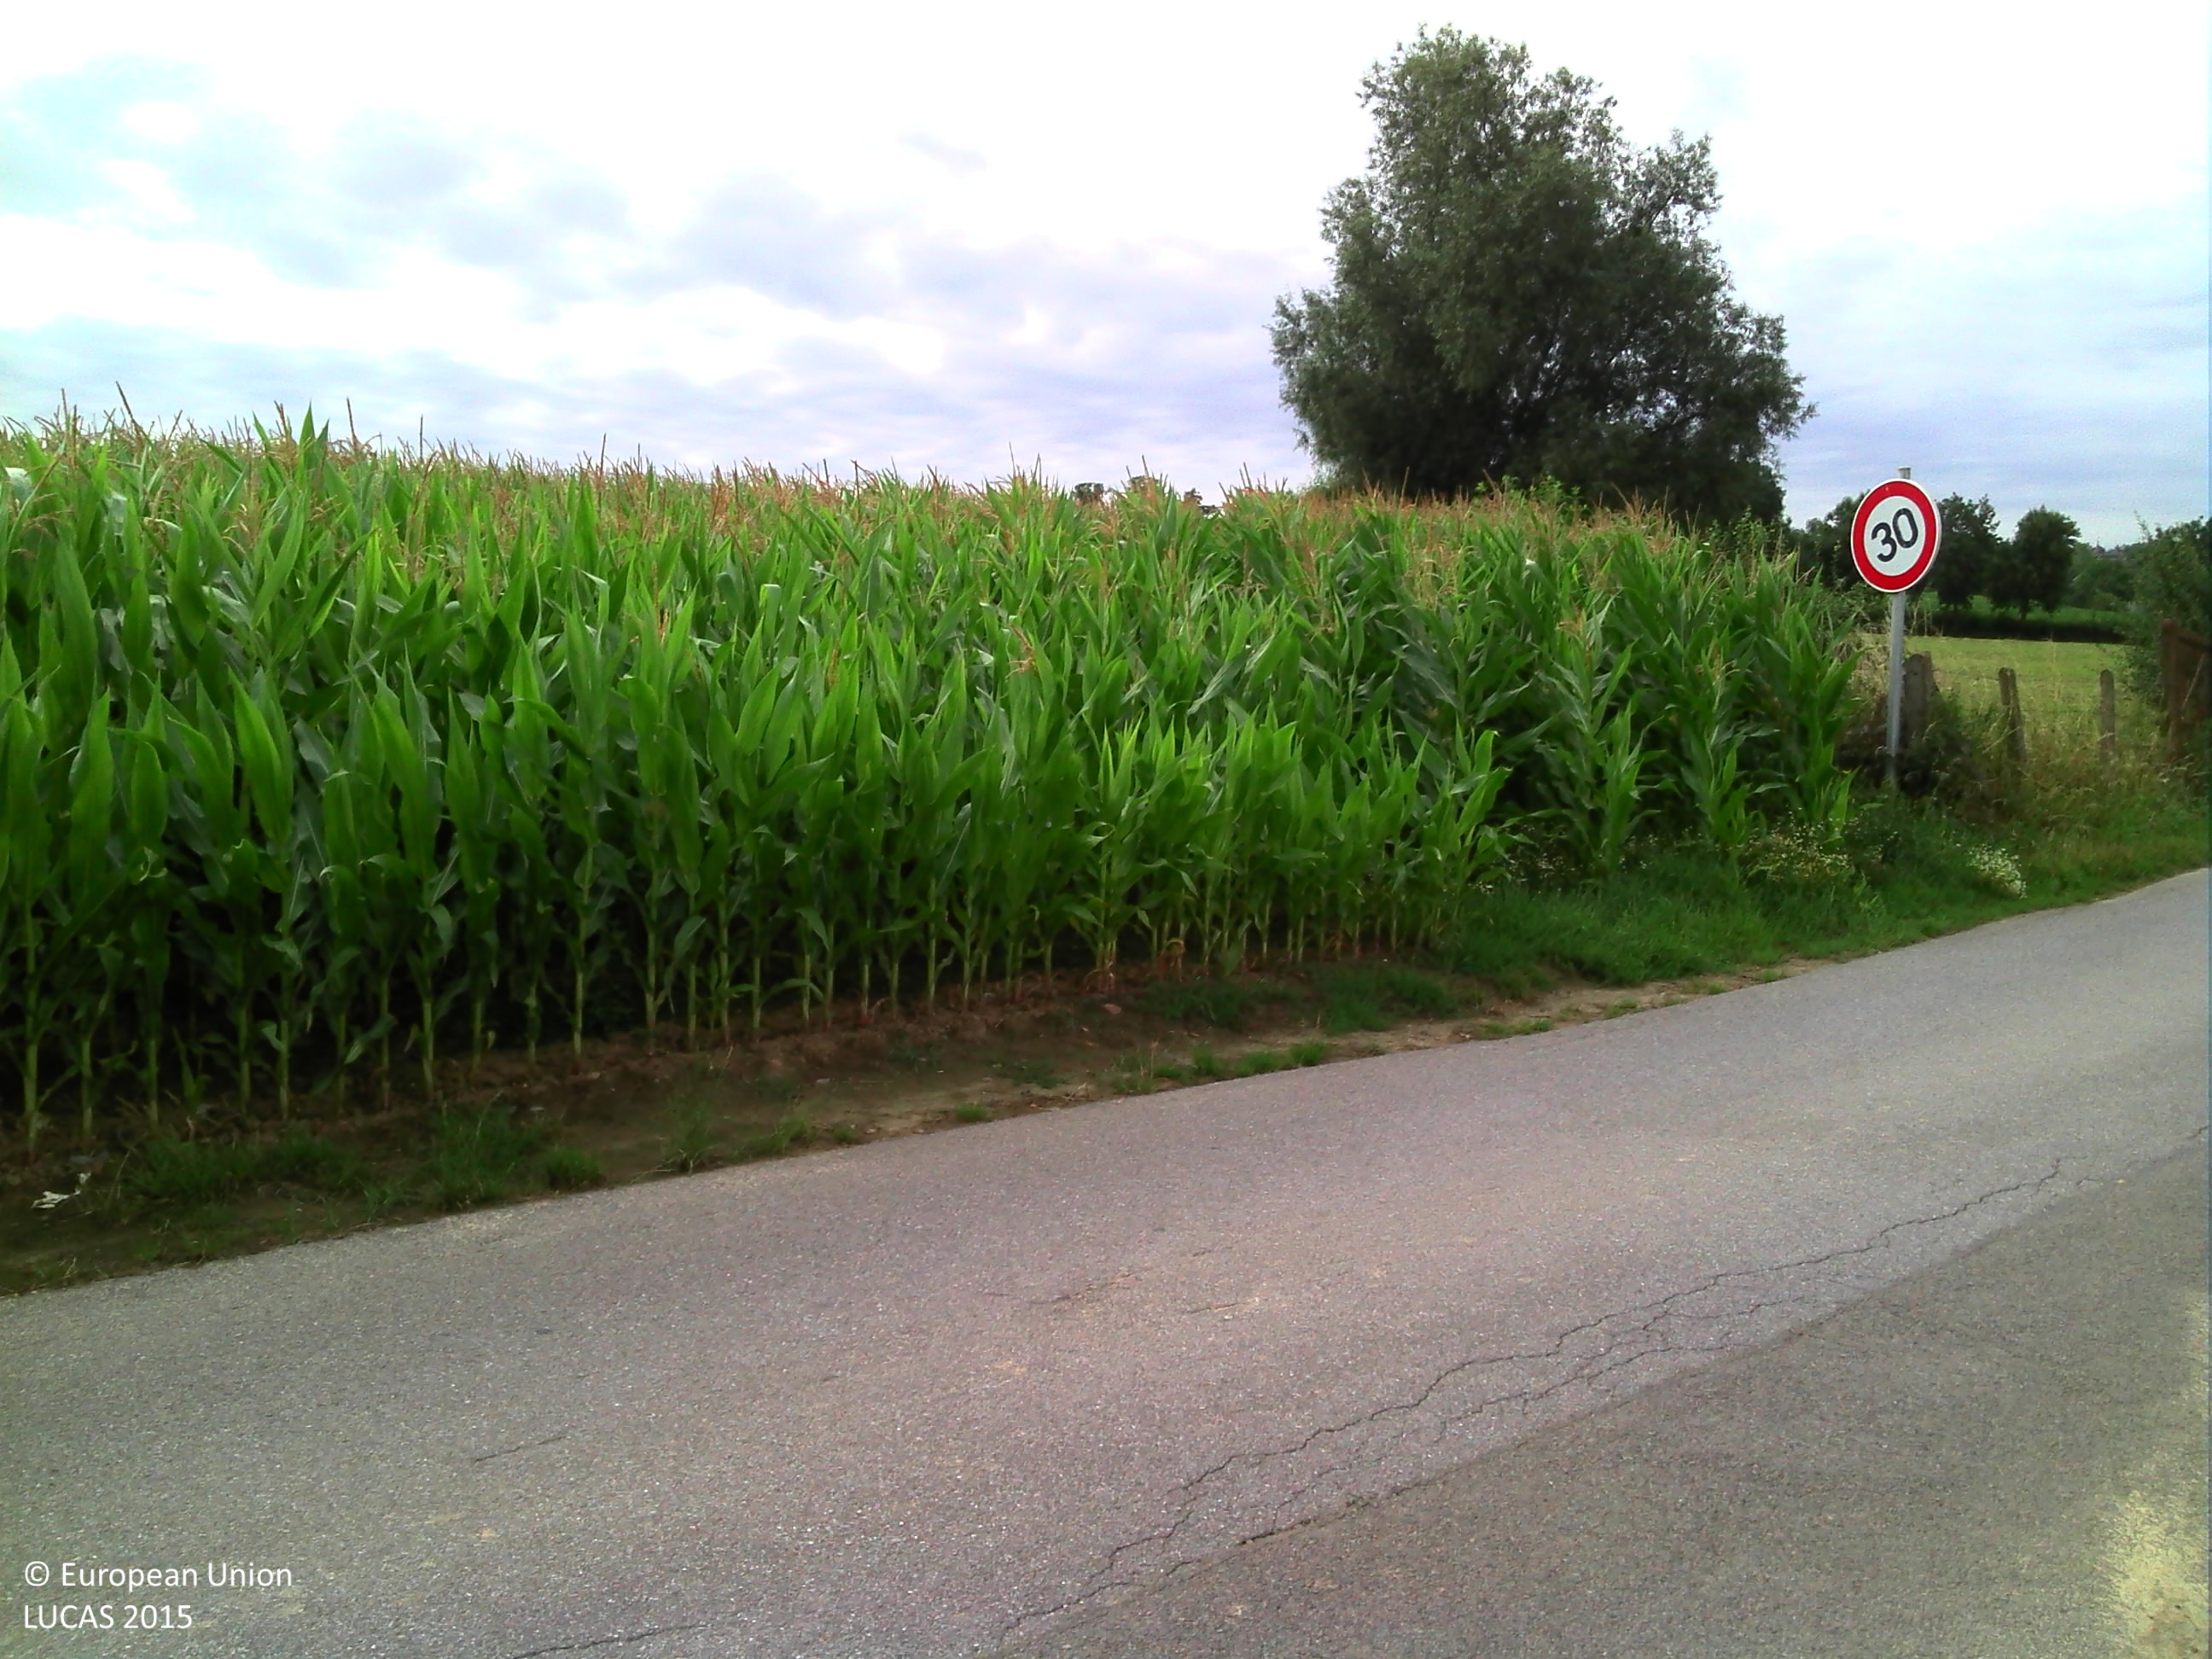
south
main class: Cropland
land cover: Maize
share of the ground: > 75 %
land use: Agriculture (excluding fallow land and kitchen gardens)
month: July
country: BE
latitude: 50.7526
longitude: 5.7321
